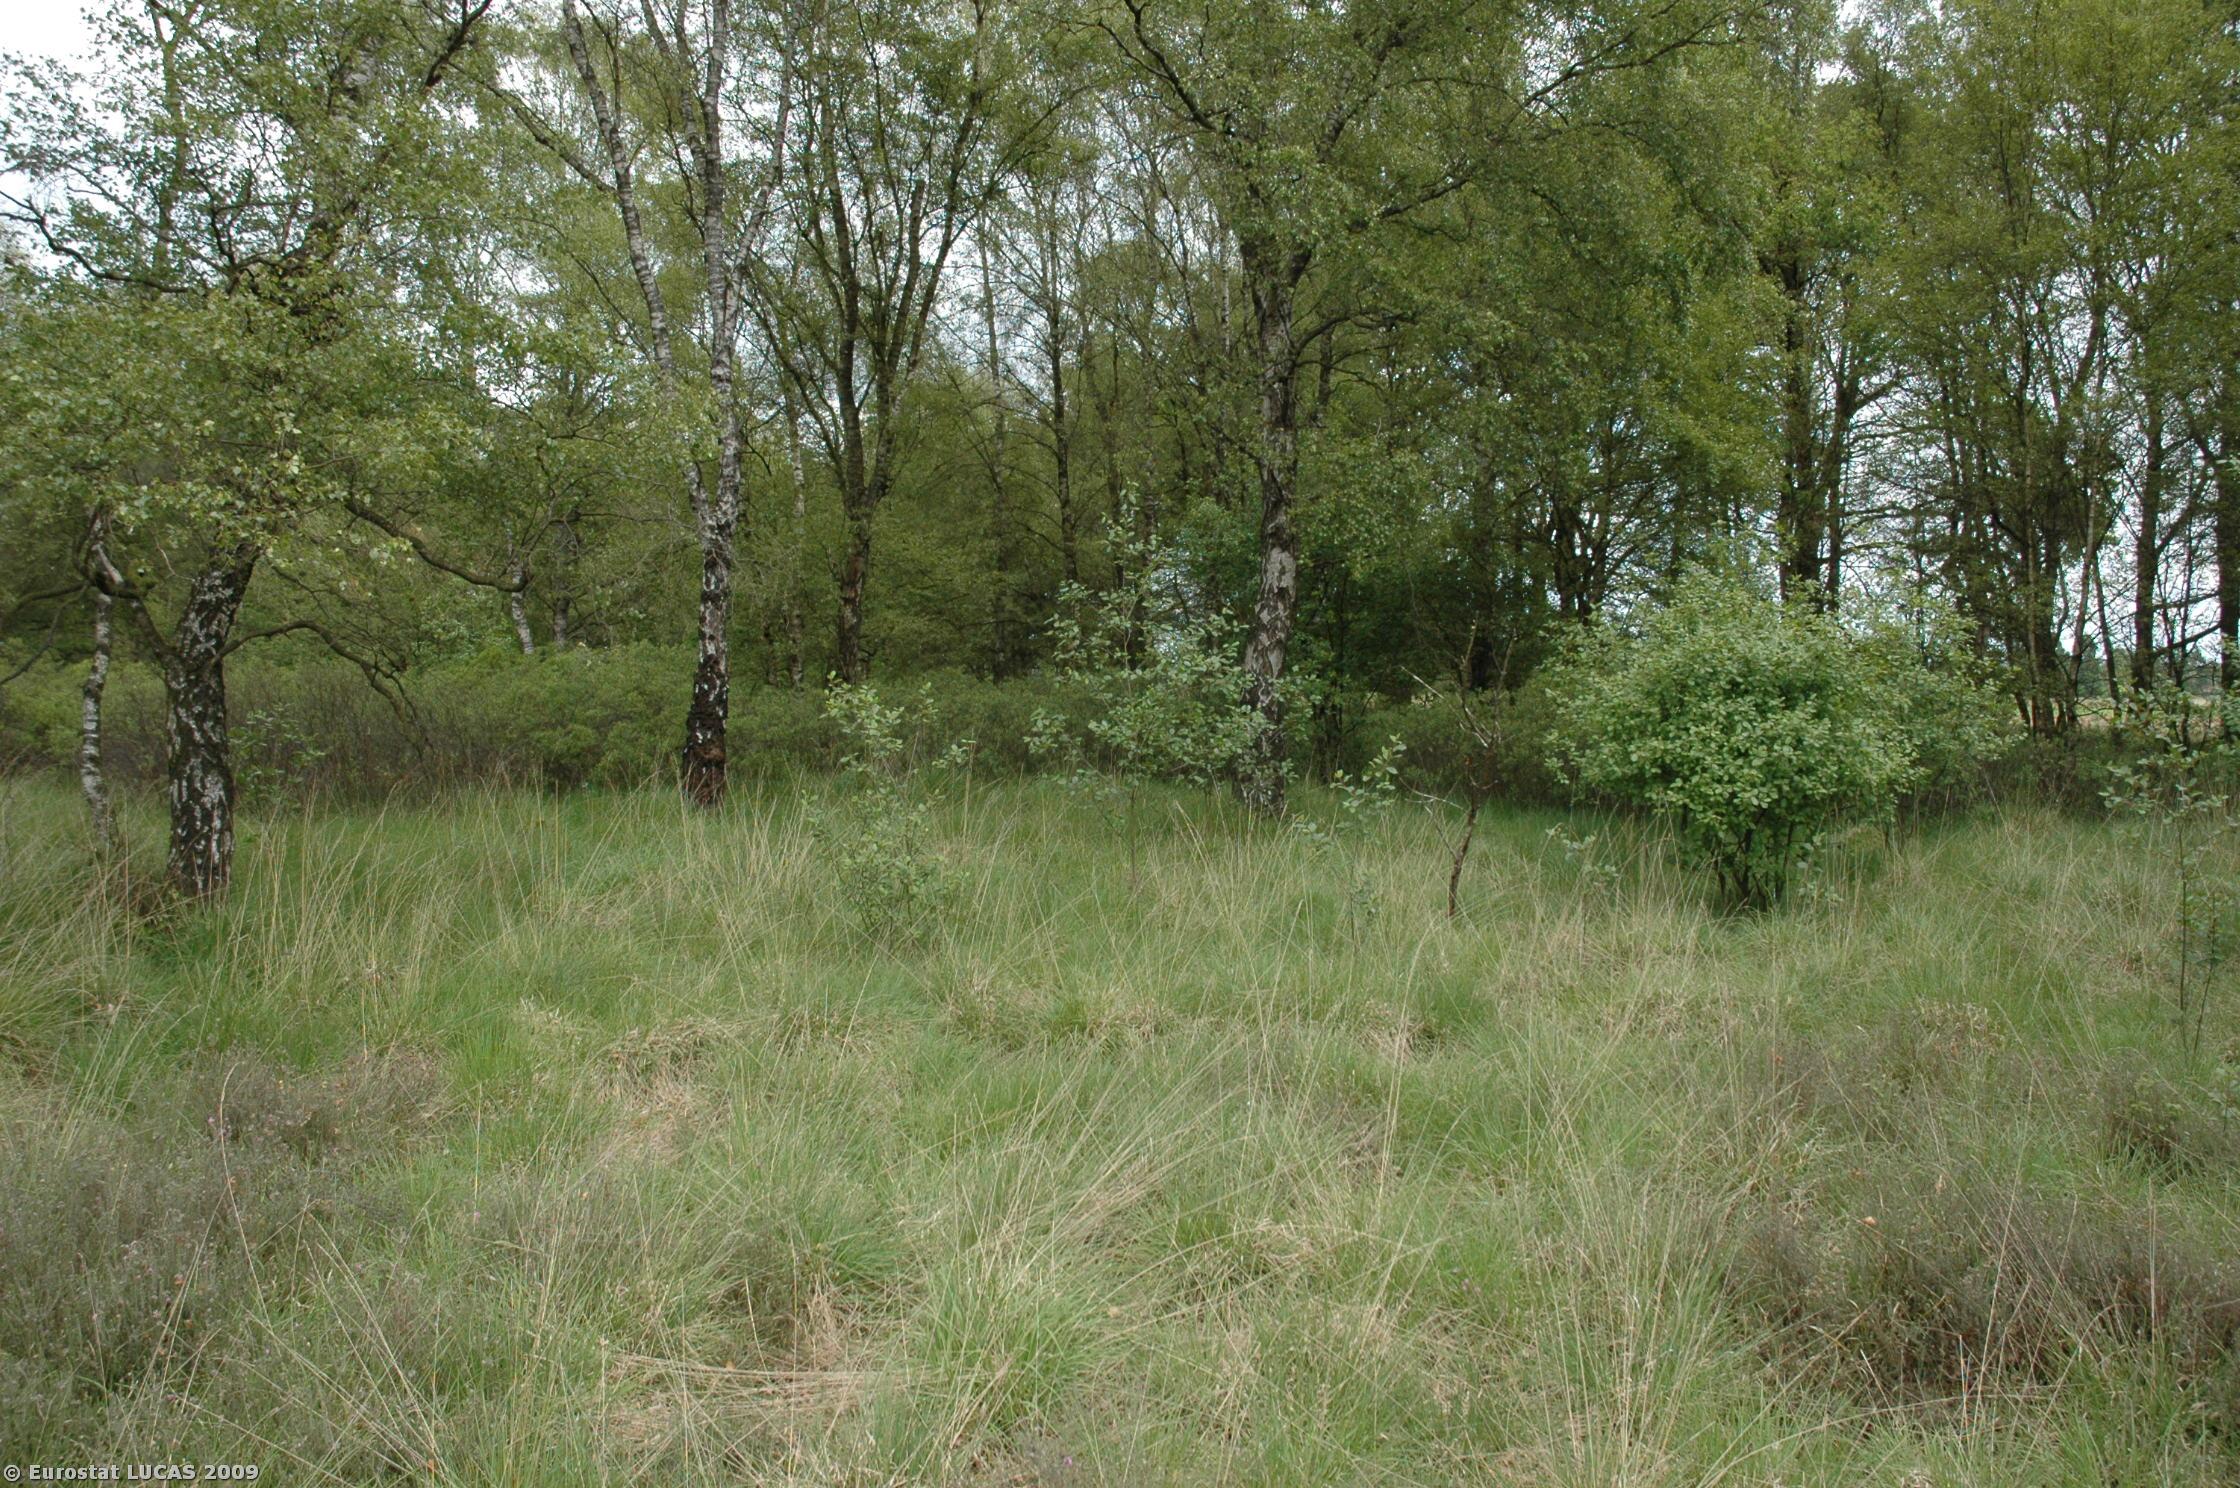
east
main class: Shrubland
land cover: Shrubland without tree cover
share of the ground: > 75 %
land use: Nature reserves
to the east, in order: Shrubland without tree cover; Broadleaved woodland; Ditches and canals; Grassland without tree/shrub cover; Ditches and canals; Fences; Grassland without tree/shrub cover; Fences; Ditches and canals; Fences; Grassland without tree/shrub cover
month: June
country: NL
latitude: 52.1335
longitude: 6.0985
